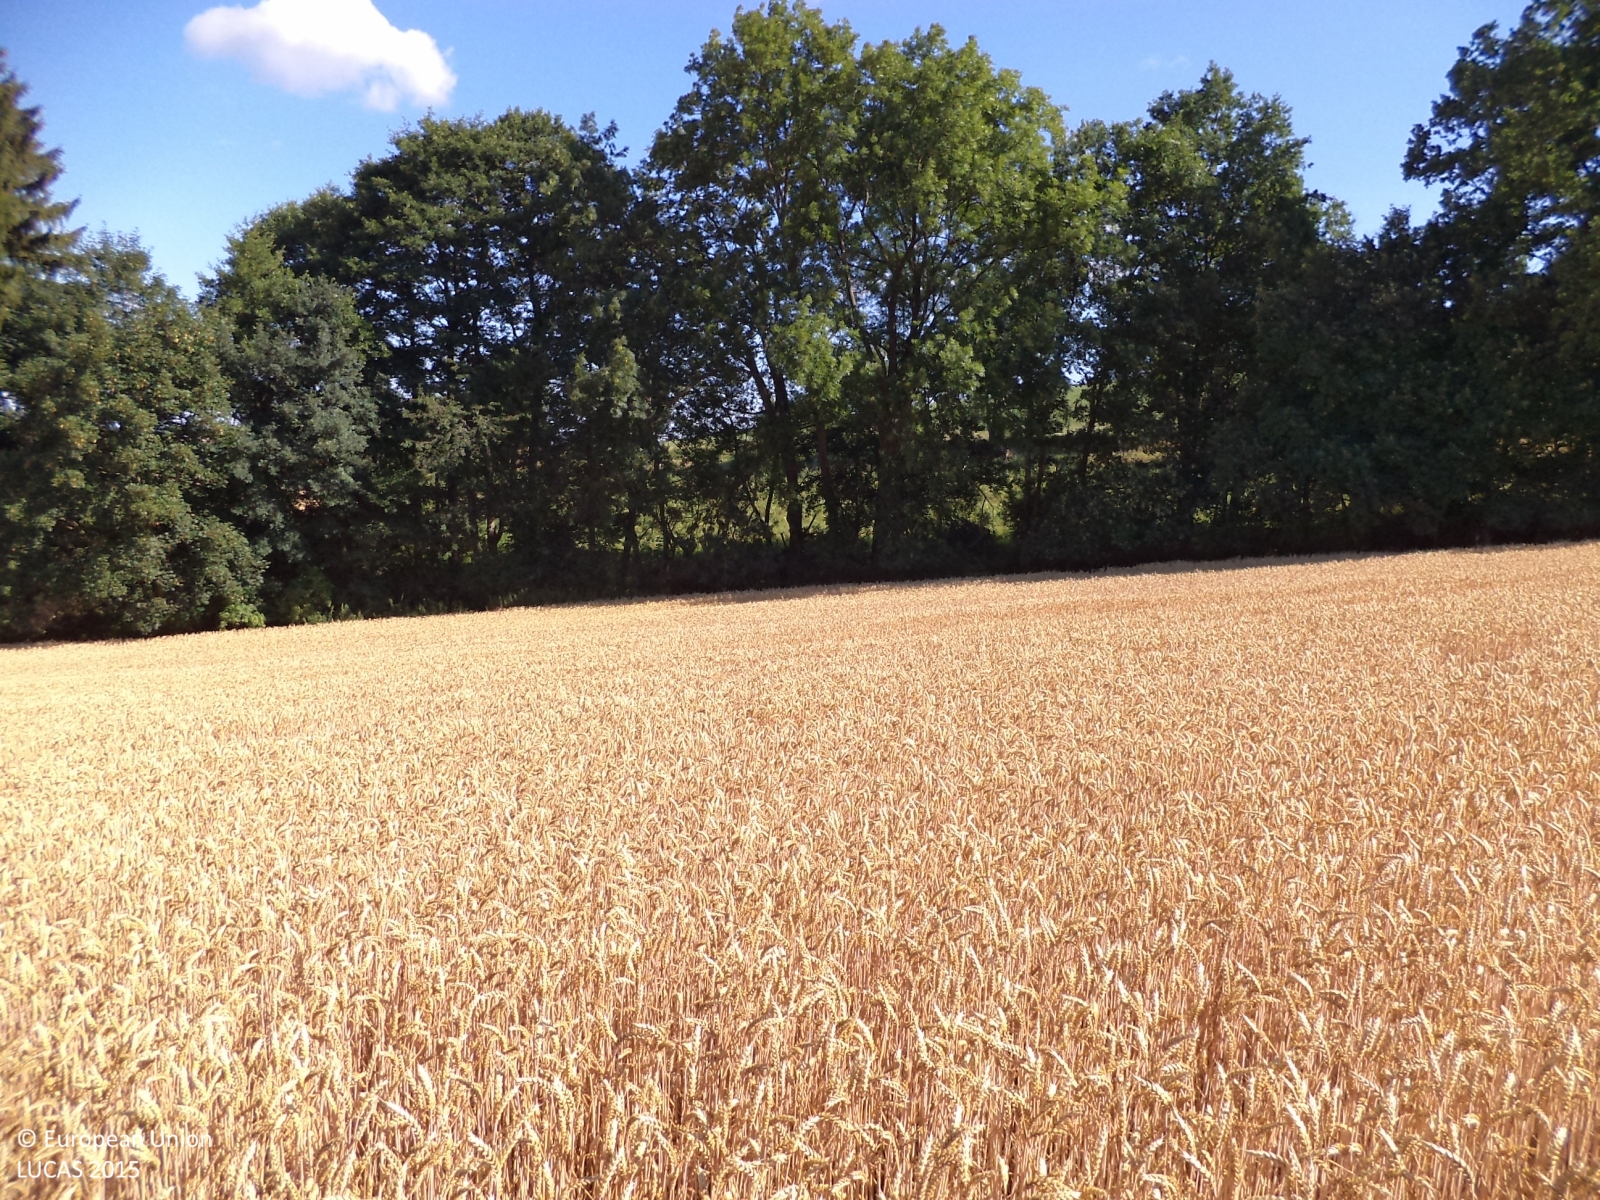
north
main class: Cropland
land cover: Common wheat
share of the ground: > 75 %
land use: Agriculture (excluding fallow land and kitchen gardens)
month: July
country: CZ
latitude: 49.7011
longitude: 14.4522
